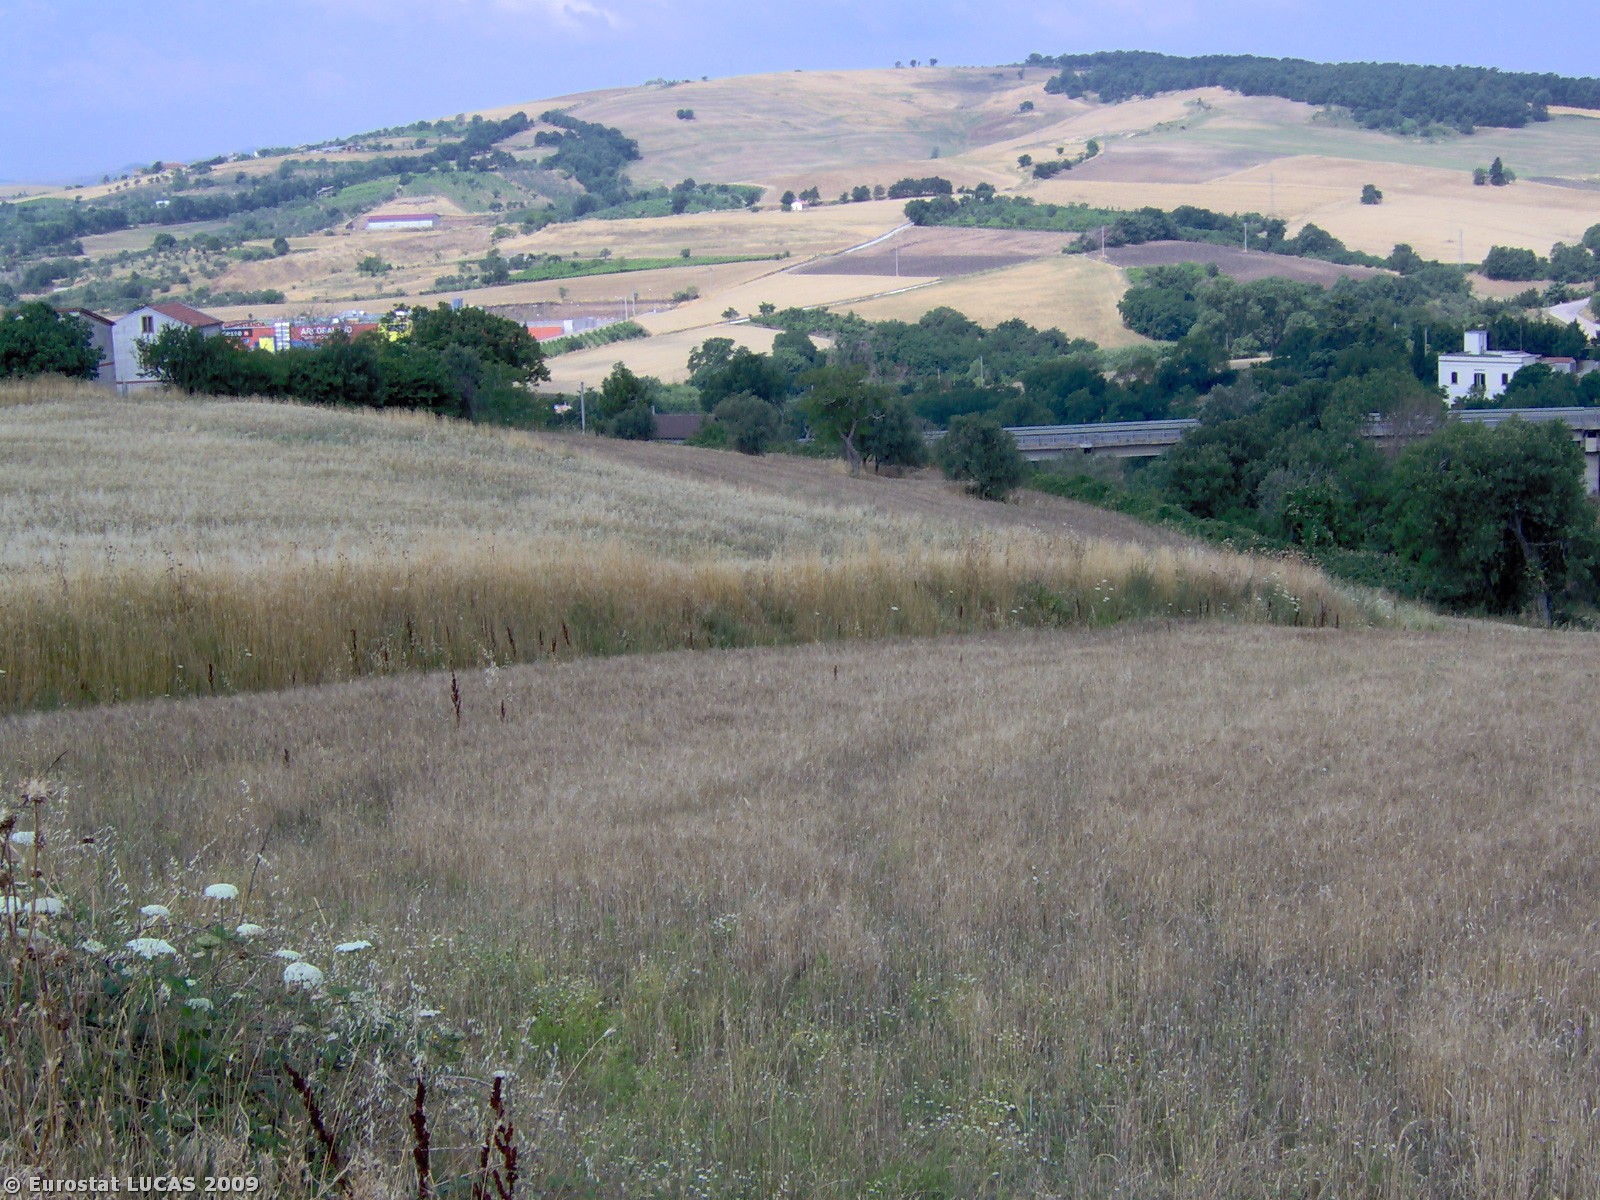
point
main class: Cropland
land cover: Durum wheat
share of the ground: > 75 %
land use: Agriculture (excluding fallow land and kitchen gardens)
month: July
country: IT
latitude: 41.0123
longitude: 15.6278
